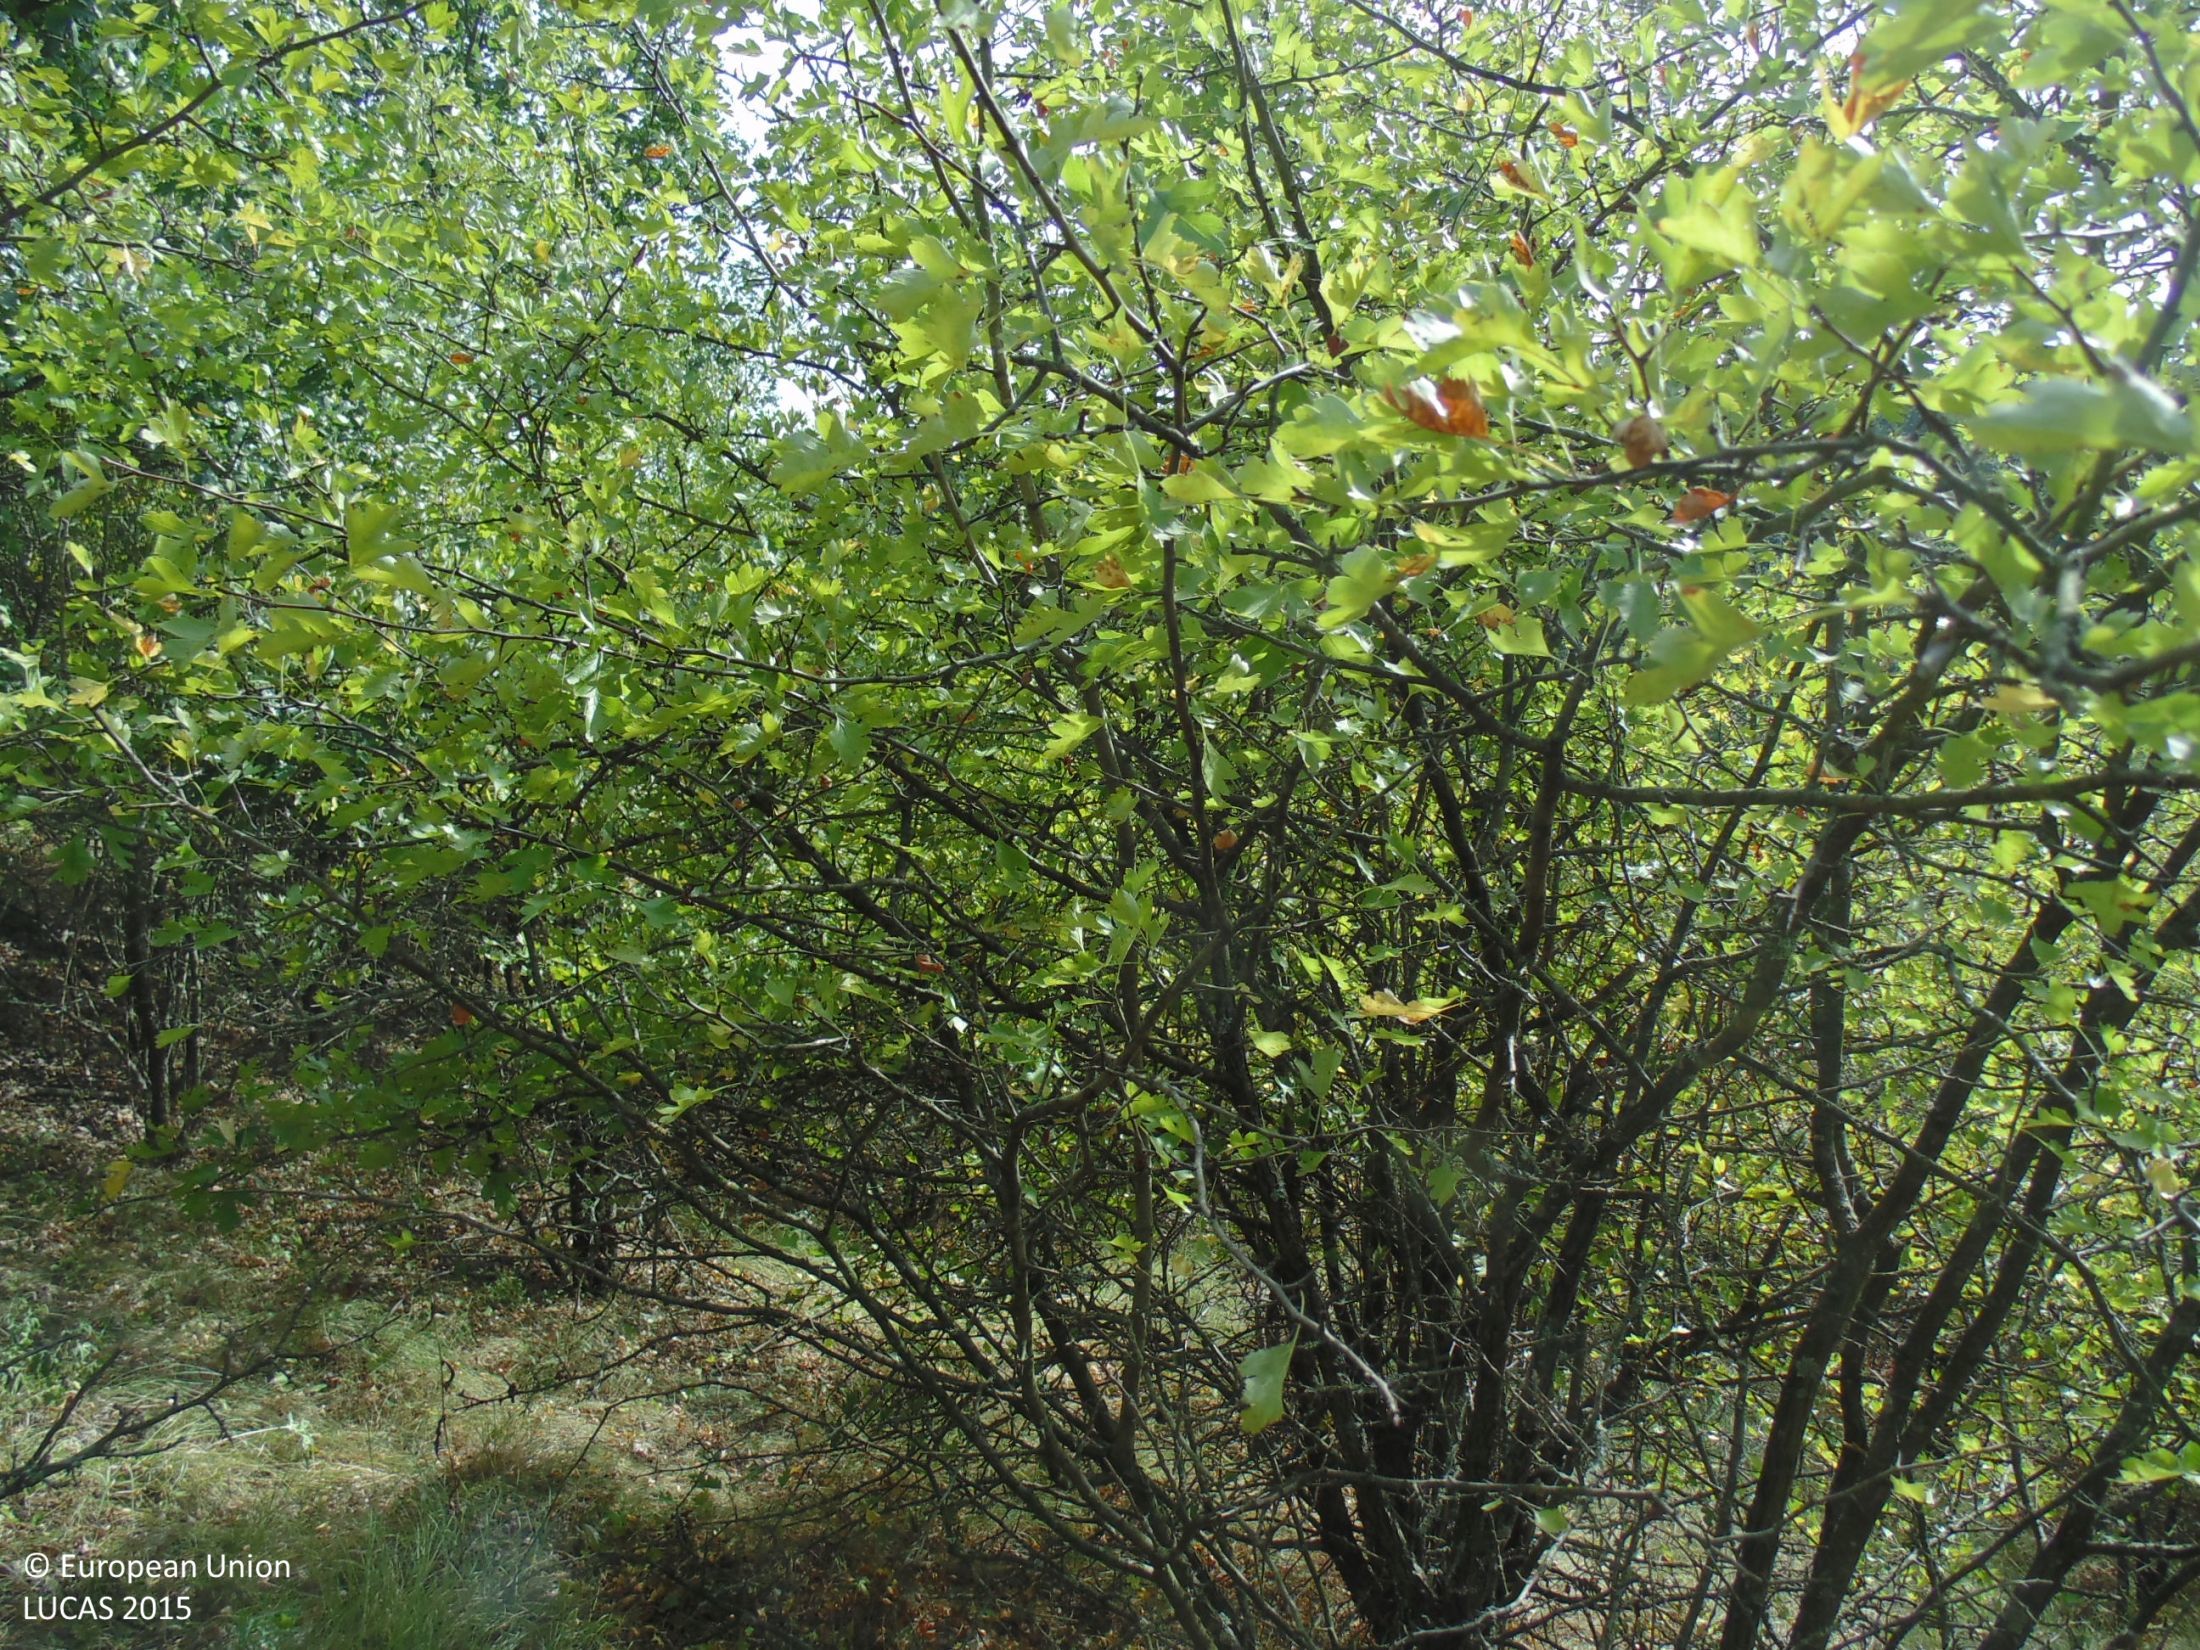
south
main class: Shrubland
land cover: Shrubland with sparse tree cover
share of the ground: 50 - 75 %
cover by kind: shrubs 65 %, herbaceous plants 30 %, broadleaved forest trees 5 %
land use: Semi-natural and natural areas not in use
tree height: < 5 m
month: September
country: BG
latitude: 43.9609
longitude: 27.1382
